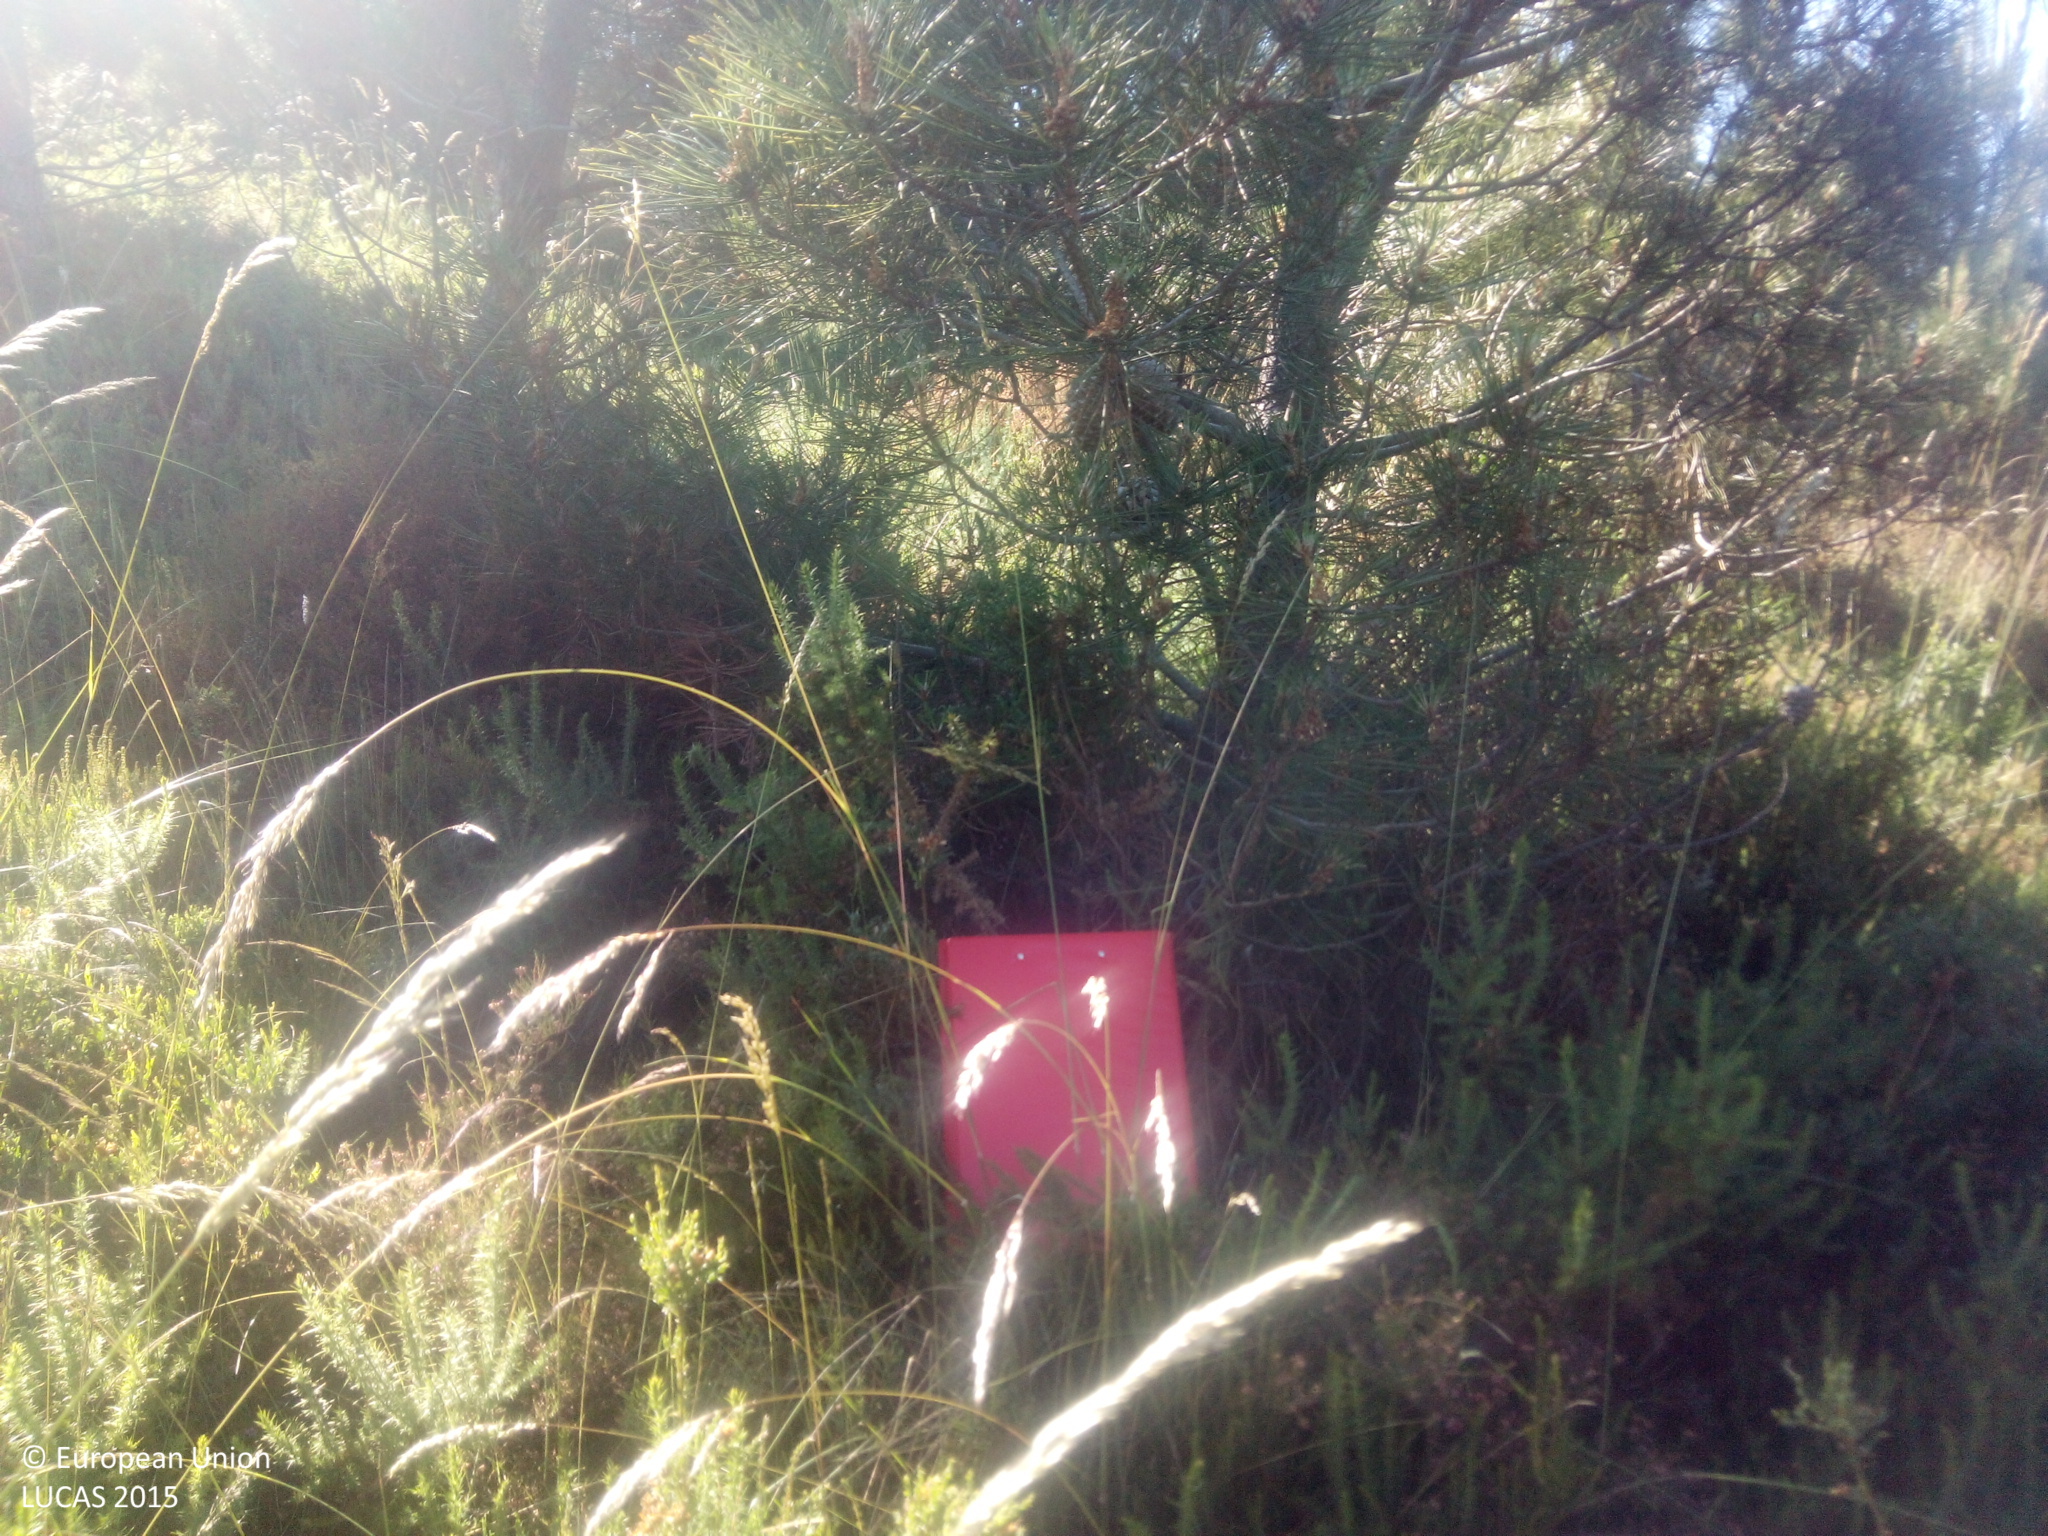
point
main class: Woodland
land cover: Pine dominated coniferous woodland
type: hemiboreal forest and nemoral coniferous forest and mixed broadleaved-coniferous forest
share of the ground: > 75 %
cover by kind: coniferous forest trees 100 %
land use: Forestry
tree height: < 5 m
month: June
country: ES
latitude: 42.4444
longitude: -8.3163
